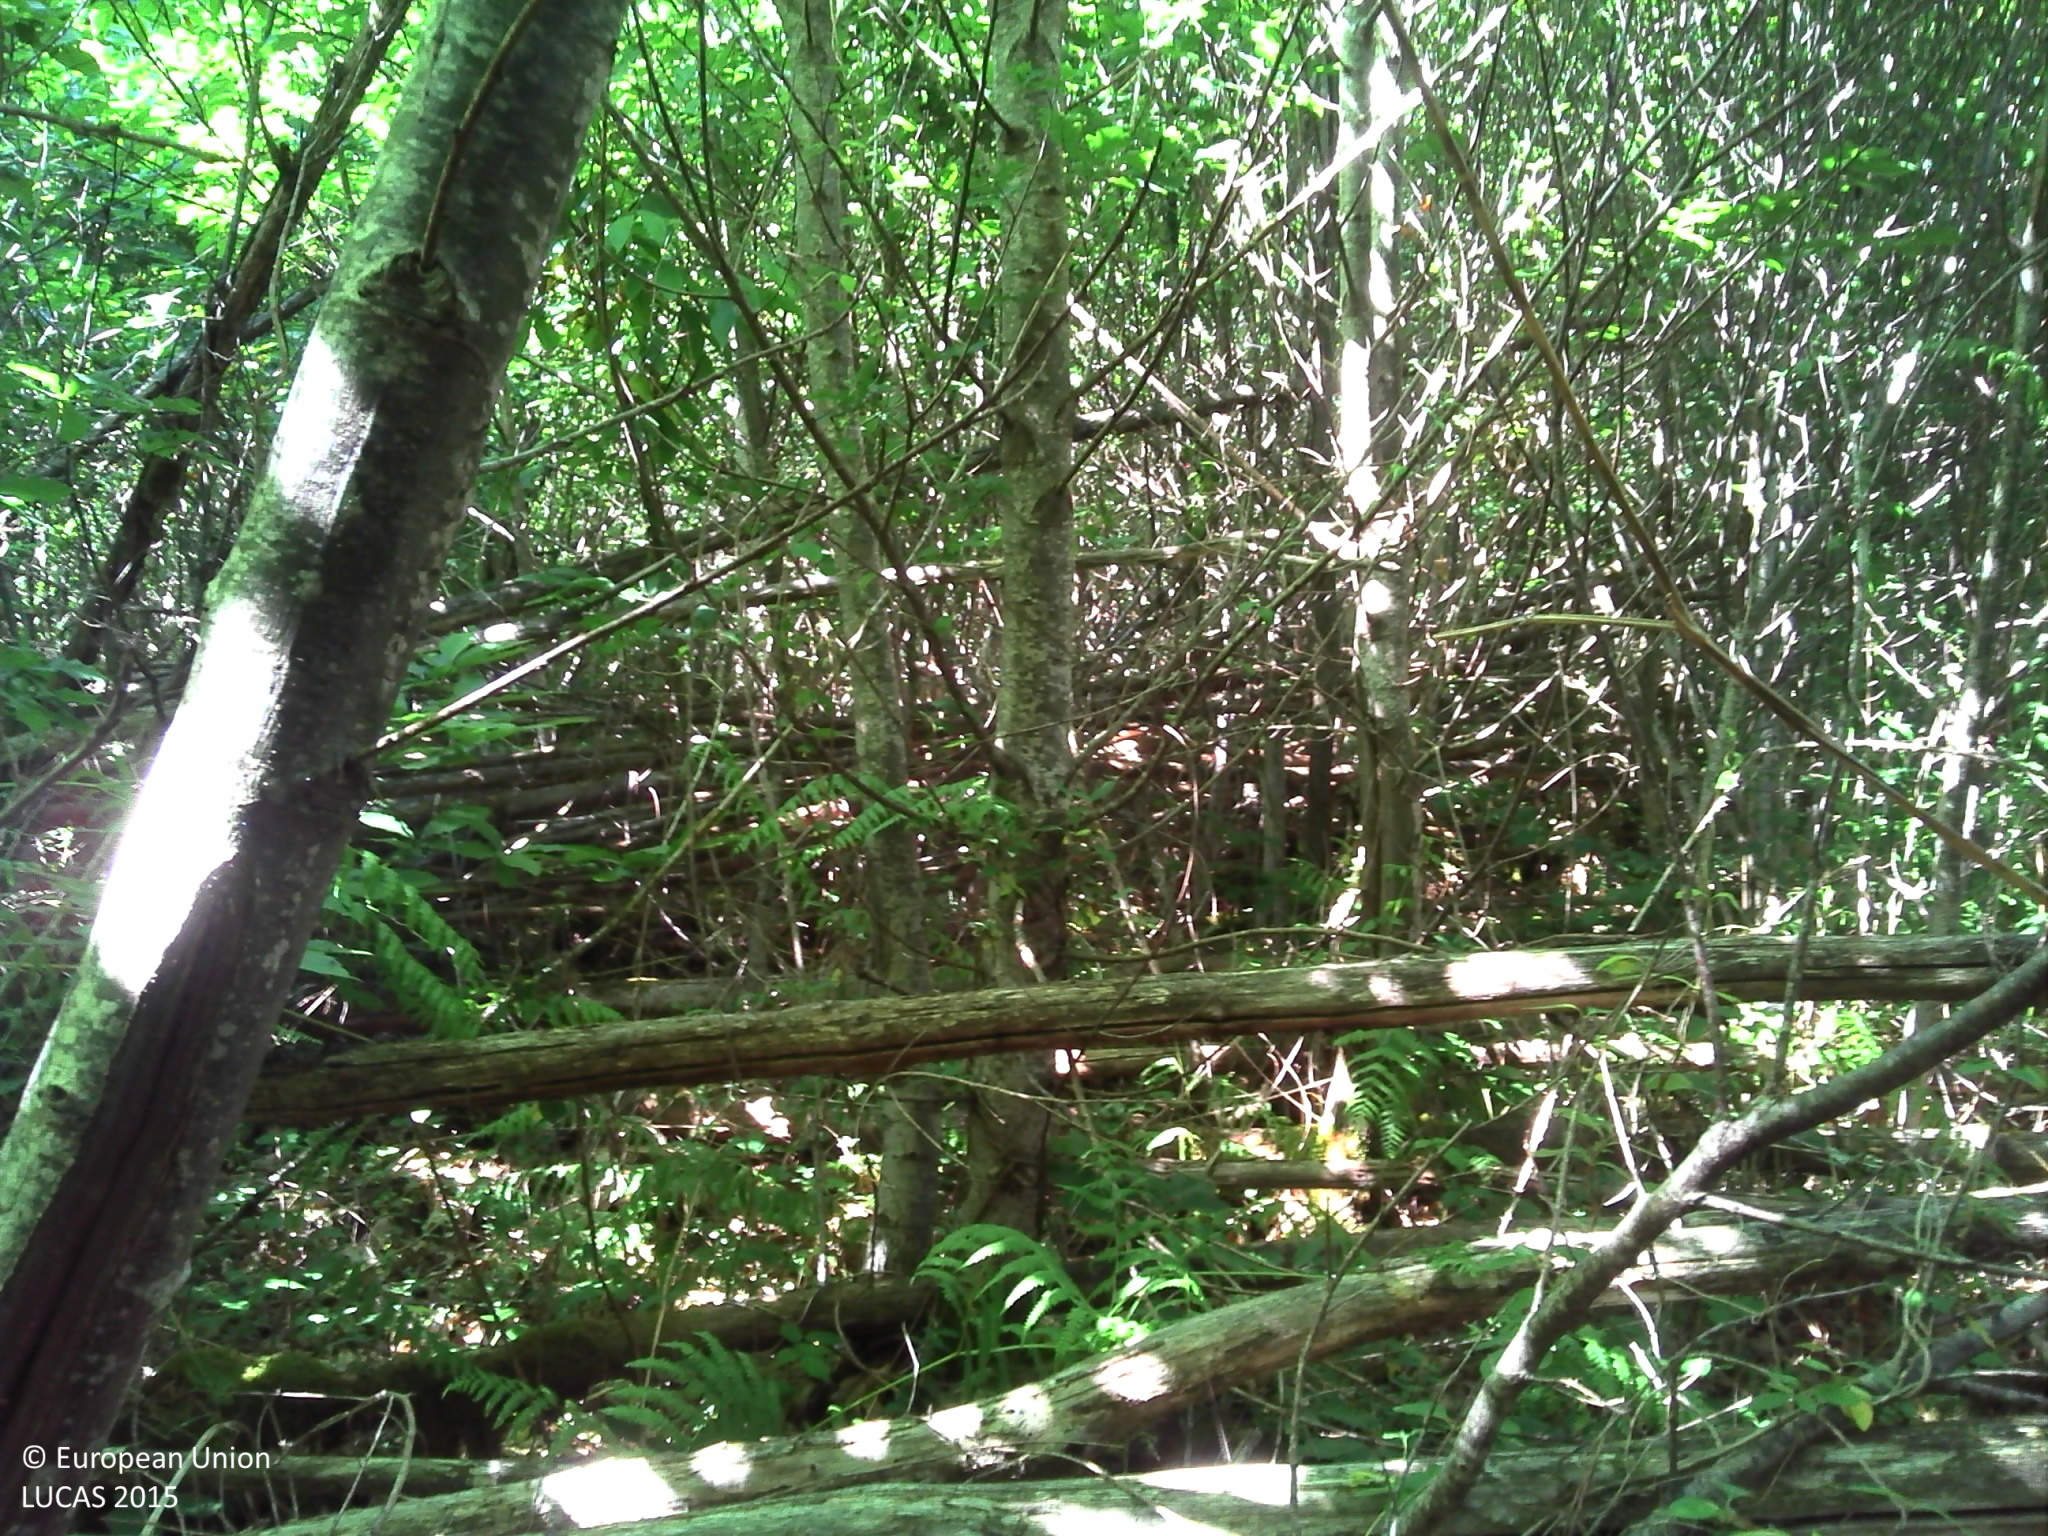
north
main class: Woodland
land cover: Broadleaved woodland
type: thermophilous deciduous forest
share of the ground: > 75 %
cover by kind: broadleaved forest trees 80 %, shrubs 15 %, herbaceous plants 5 %
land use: Semi-natural and natural areas not in use
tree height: > 5 m
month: June
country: FR
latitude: 45.7610
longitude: 0.6656
